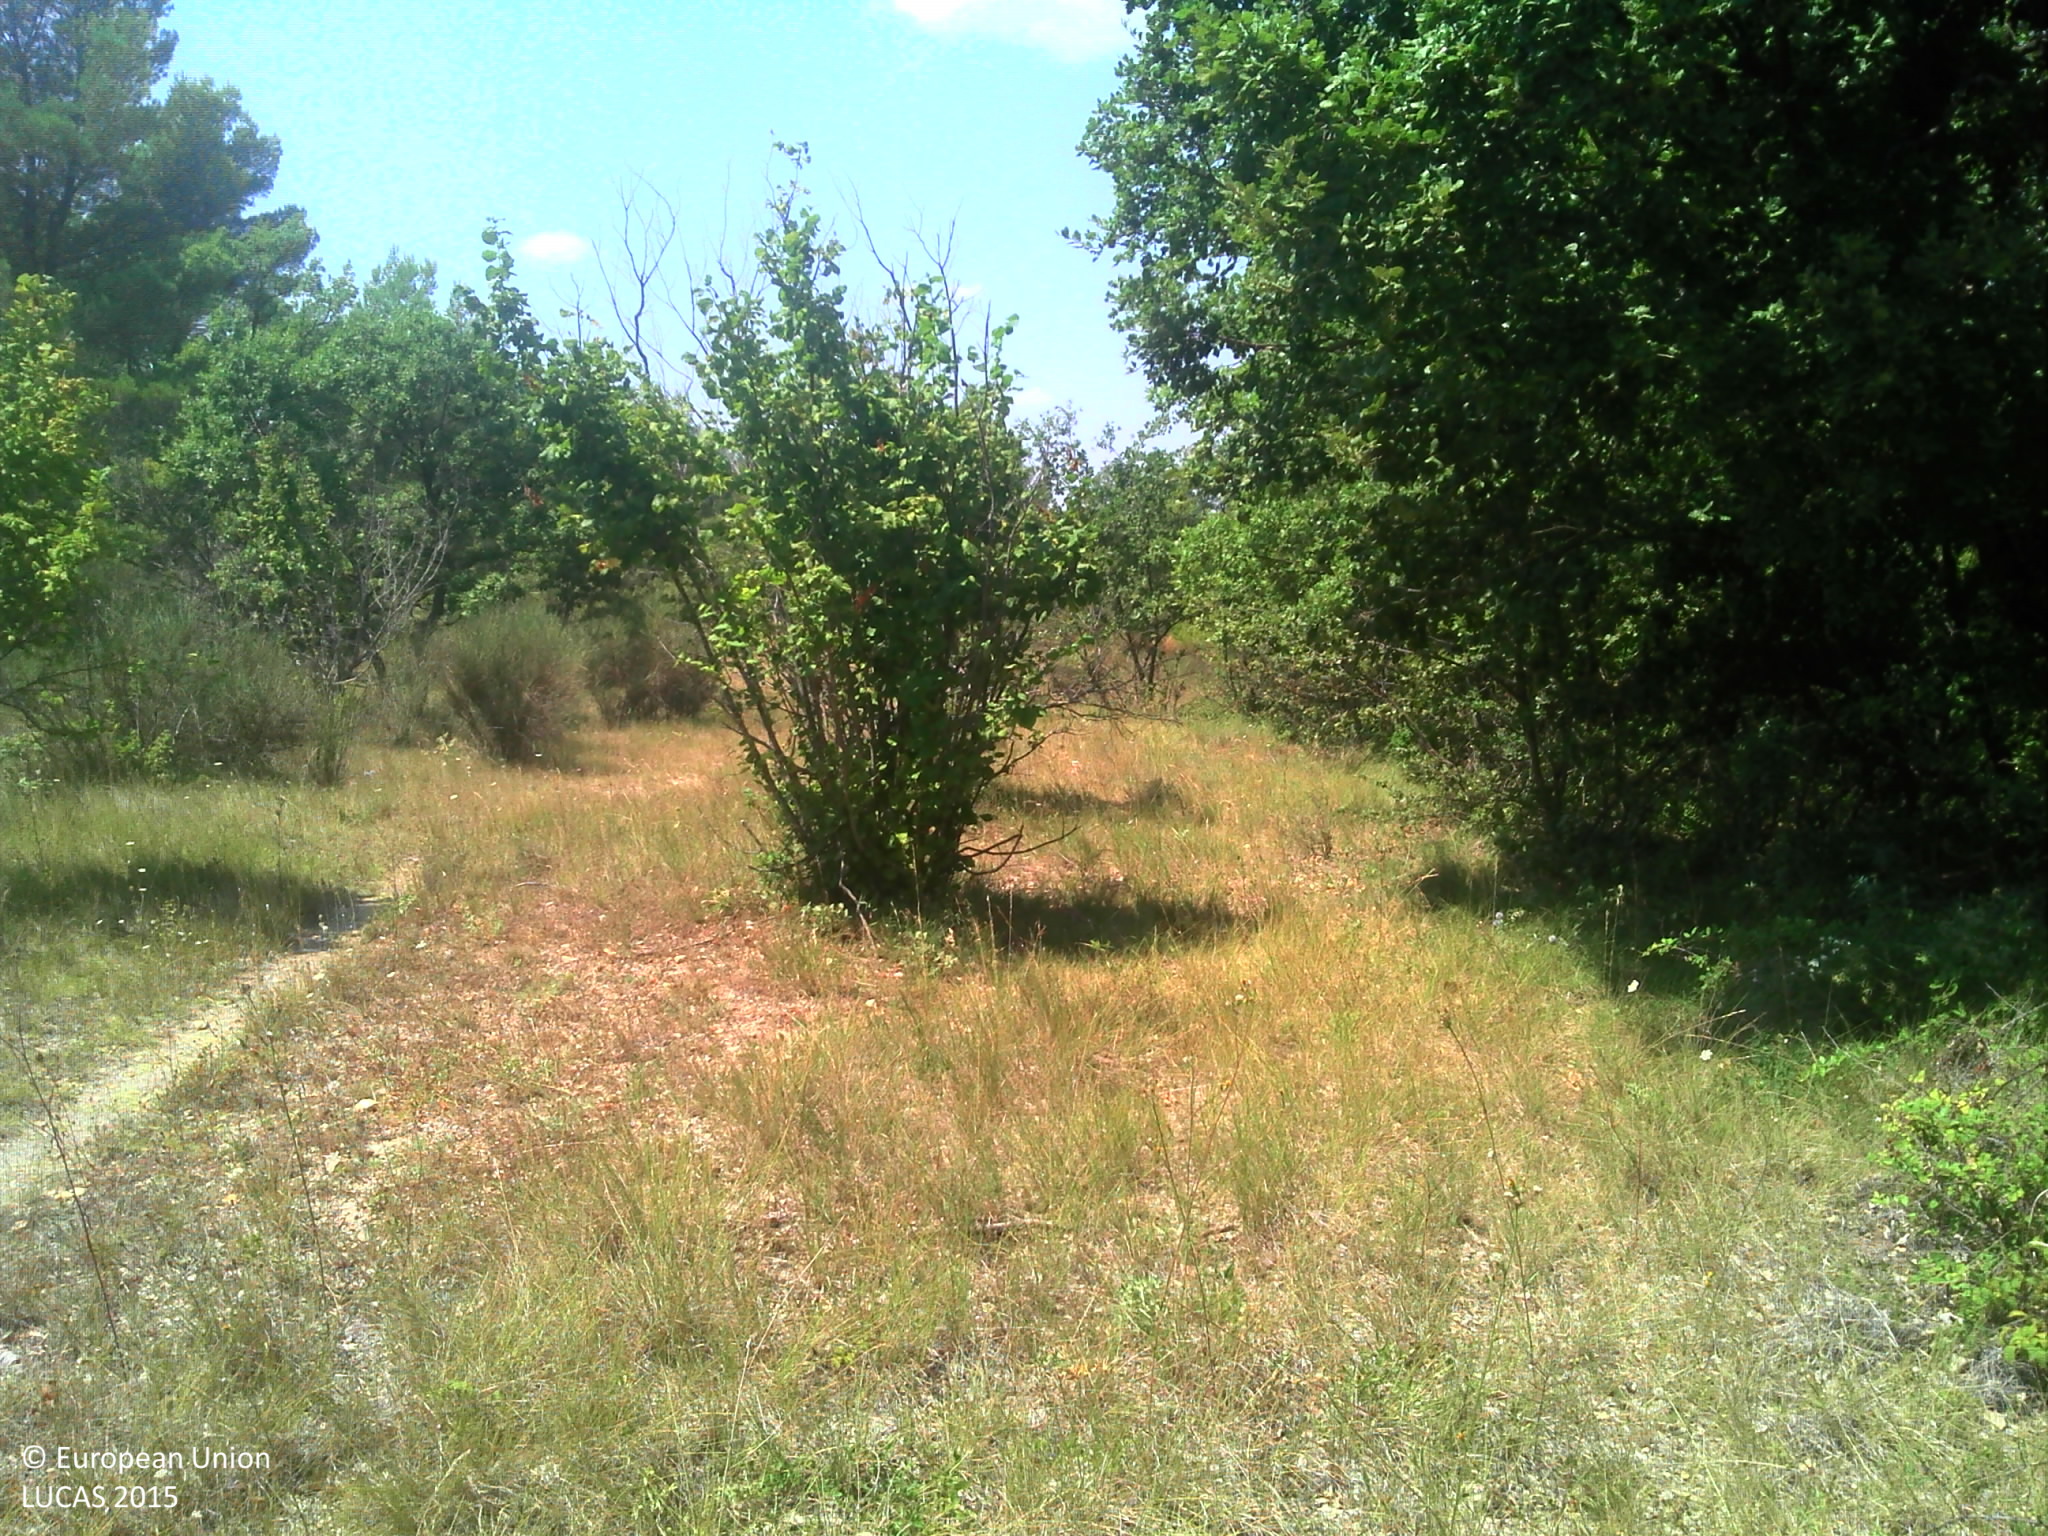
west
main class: Woodland
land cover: Broadleaved woodland
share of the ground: > 75 %
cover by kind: broadleaved forest trees 60 %, herbaceous plants 30 %, unconsolidated bare surface 10 %
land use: Forestry
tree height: > 5 m
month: August
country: FR
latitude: 43.5163
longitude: 5.5932
